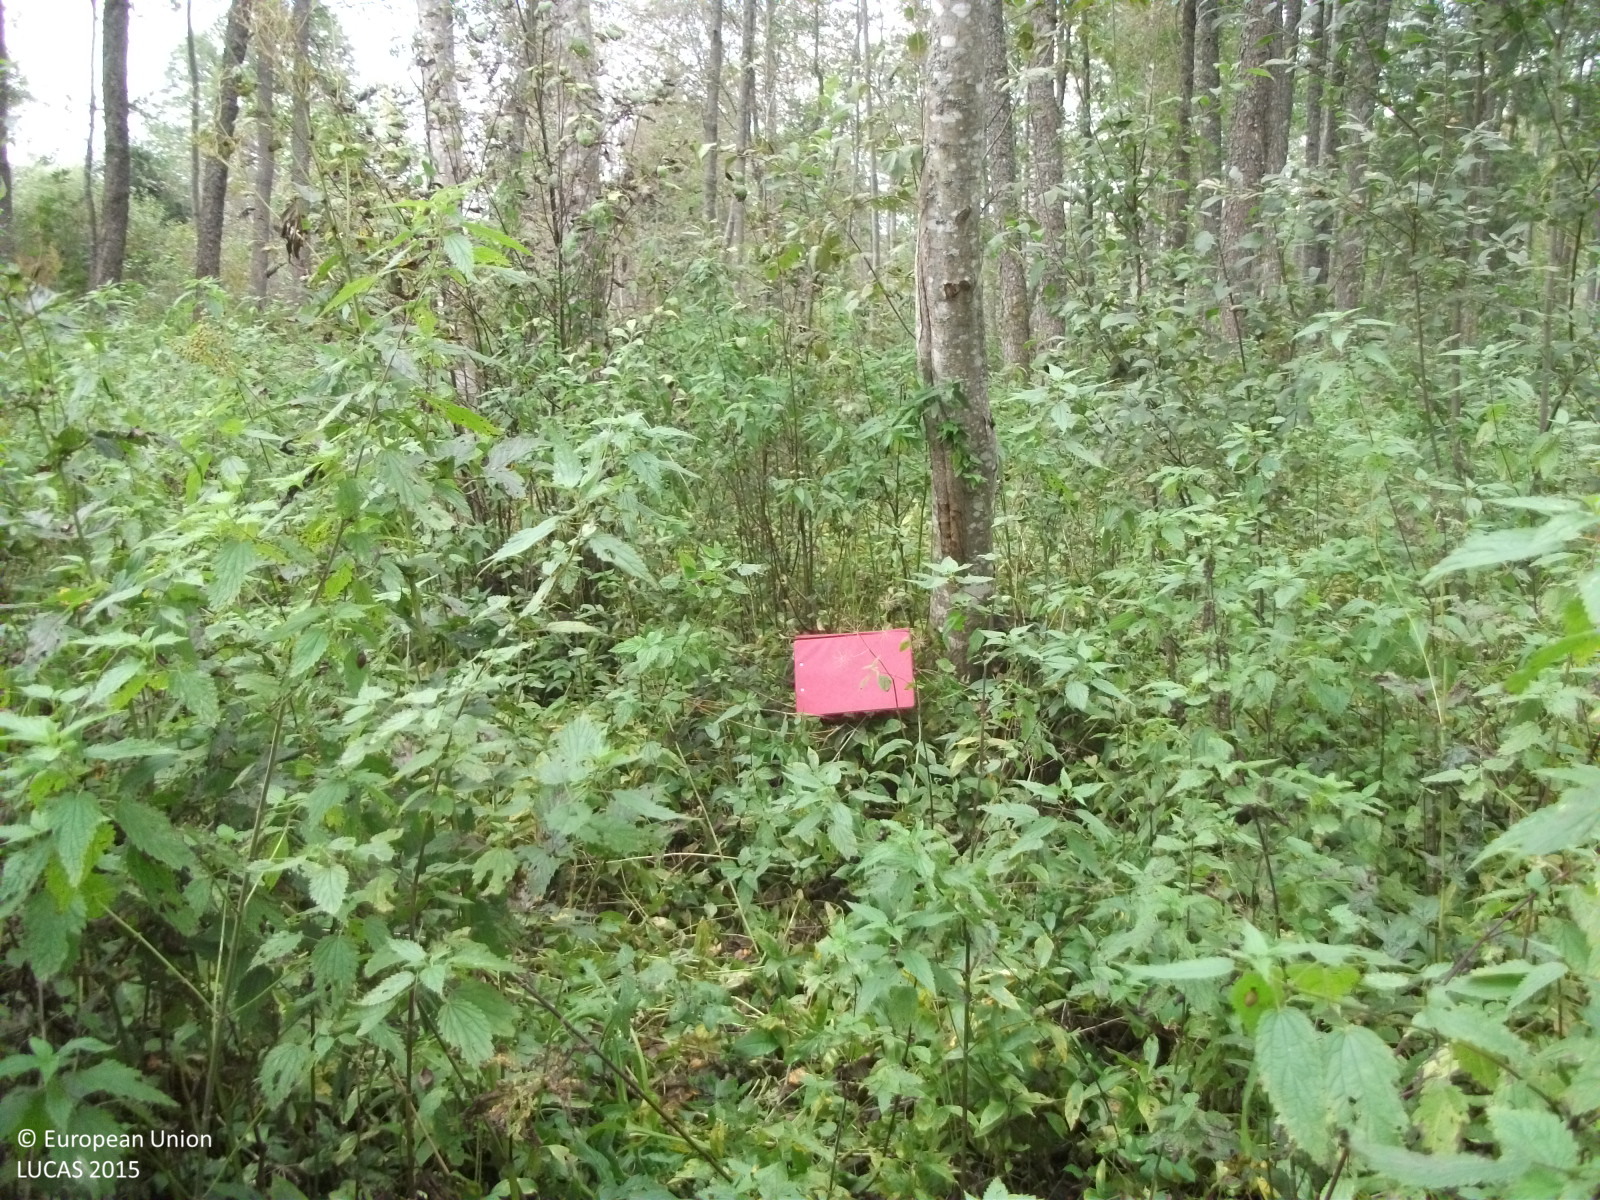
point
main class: Woodland
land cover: Broadleaved woodland
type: non-riverine alder, birch or aspen forest
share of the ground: 50 - 75 %
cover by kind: broadleaved forest trees 70 %, herbaceous plants 20 %, shrubs 10 %
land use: Forestry
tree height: > 5 m
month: September
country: LV
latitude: 57.7498
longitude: 24.7295
